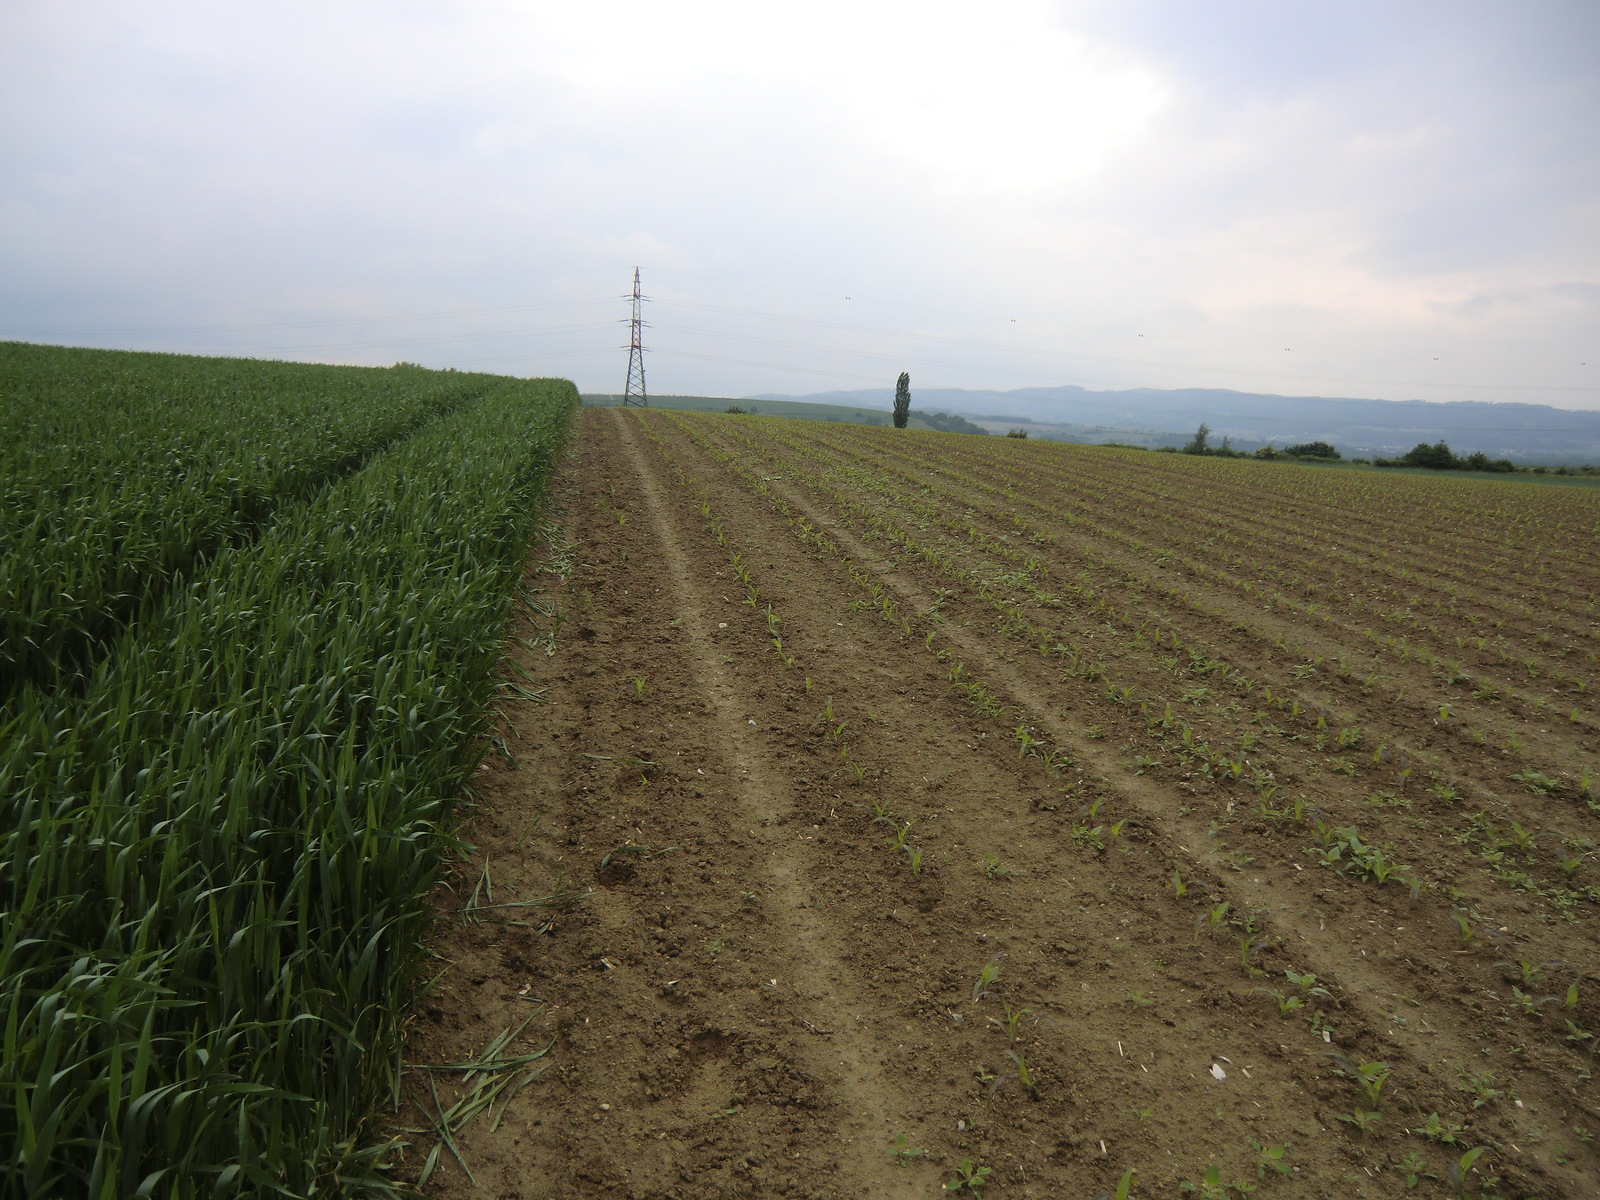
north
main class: Cropland
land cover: Common wheat
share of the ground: > 75 %
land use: Agriculture (excluding fallow land and kitchen gardens)
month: May
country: AT
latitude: 48.1790
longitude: 15.4490
